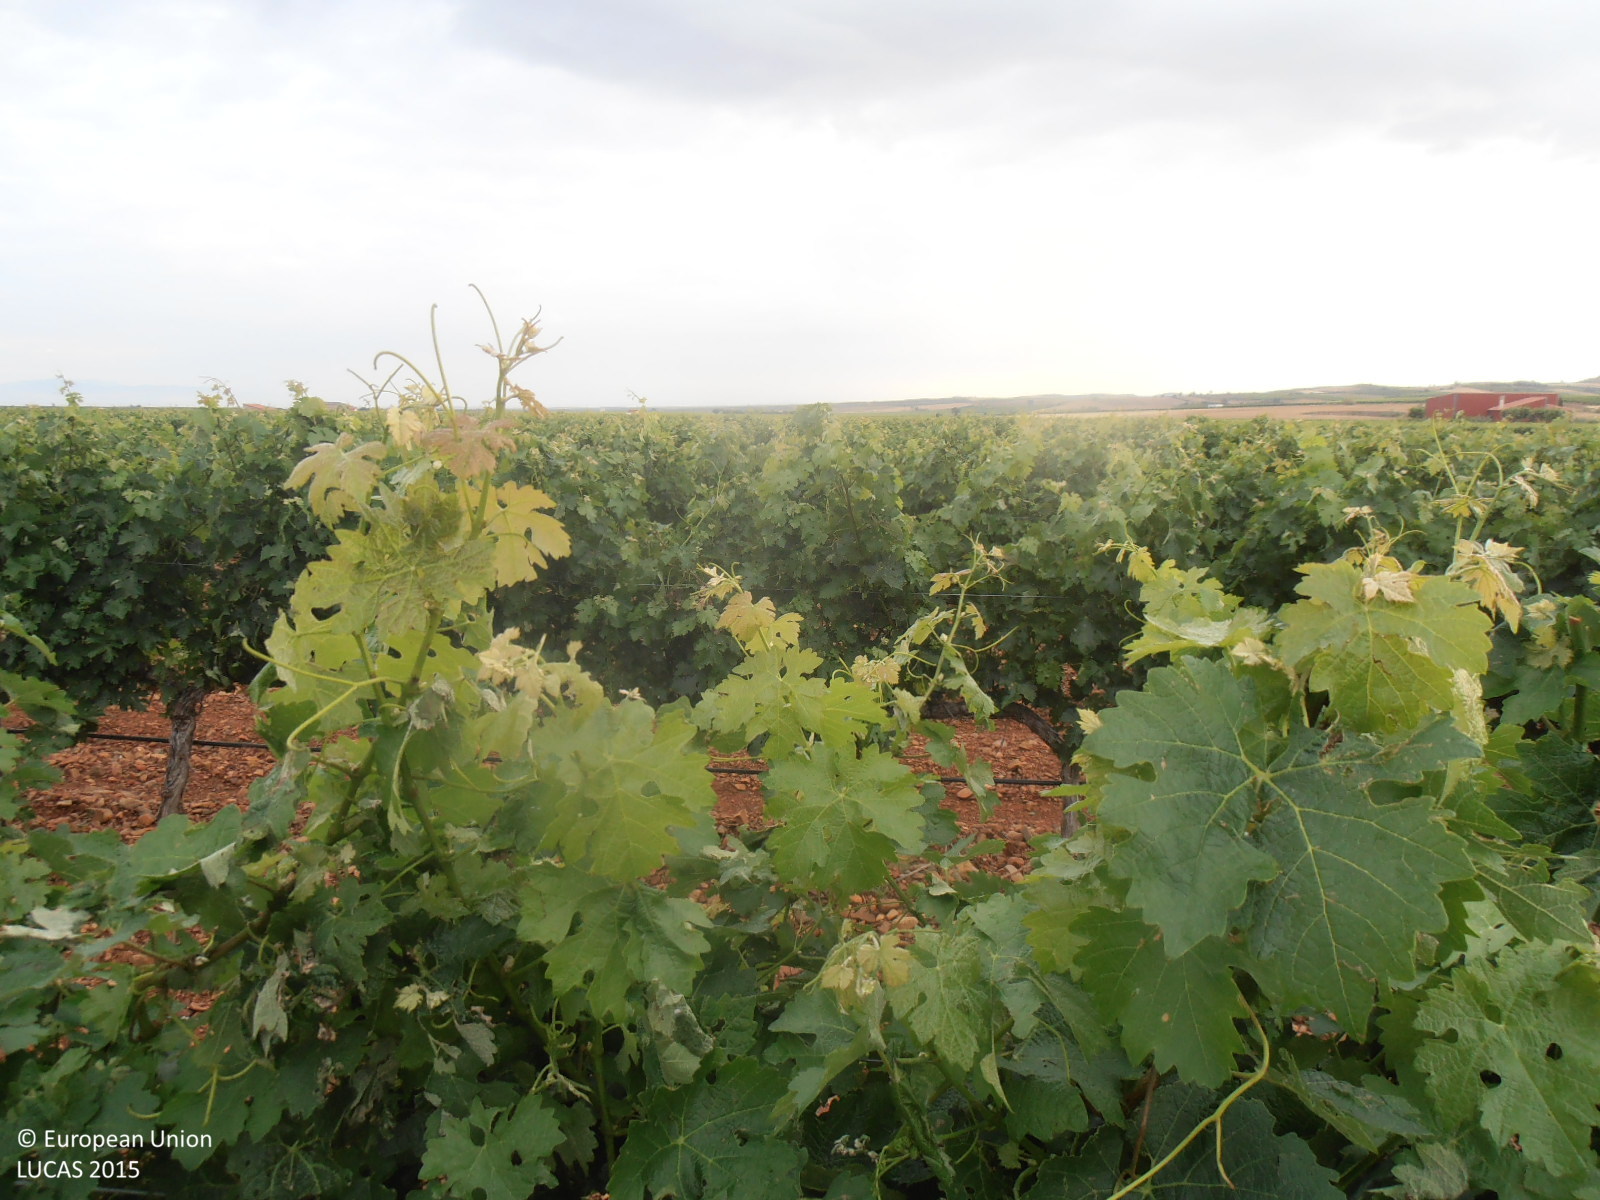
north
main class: Cropland
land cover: Vineyards
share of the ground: 25 - 50 %
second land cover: Other bare soil
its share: > 75 %
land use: Agriculture (excluding fallow land and kitchen gardens)
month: June
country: ES
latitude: 41.3926
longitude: -1.2042
